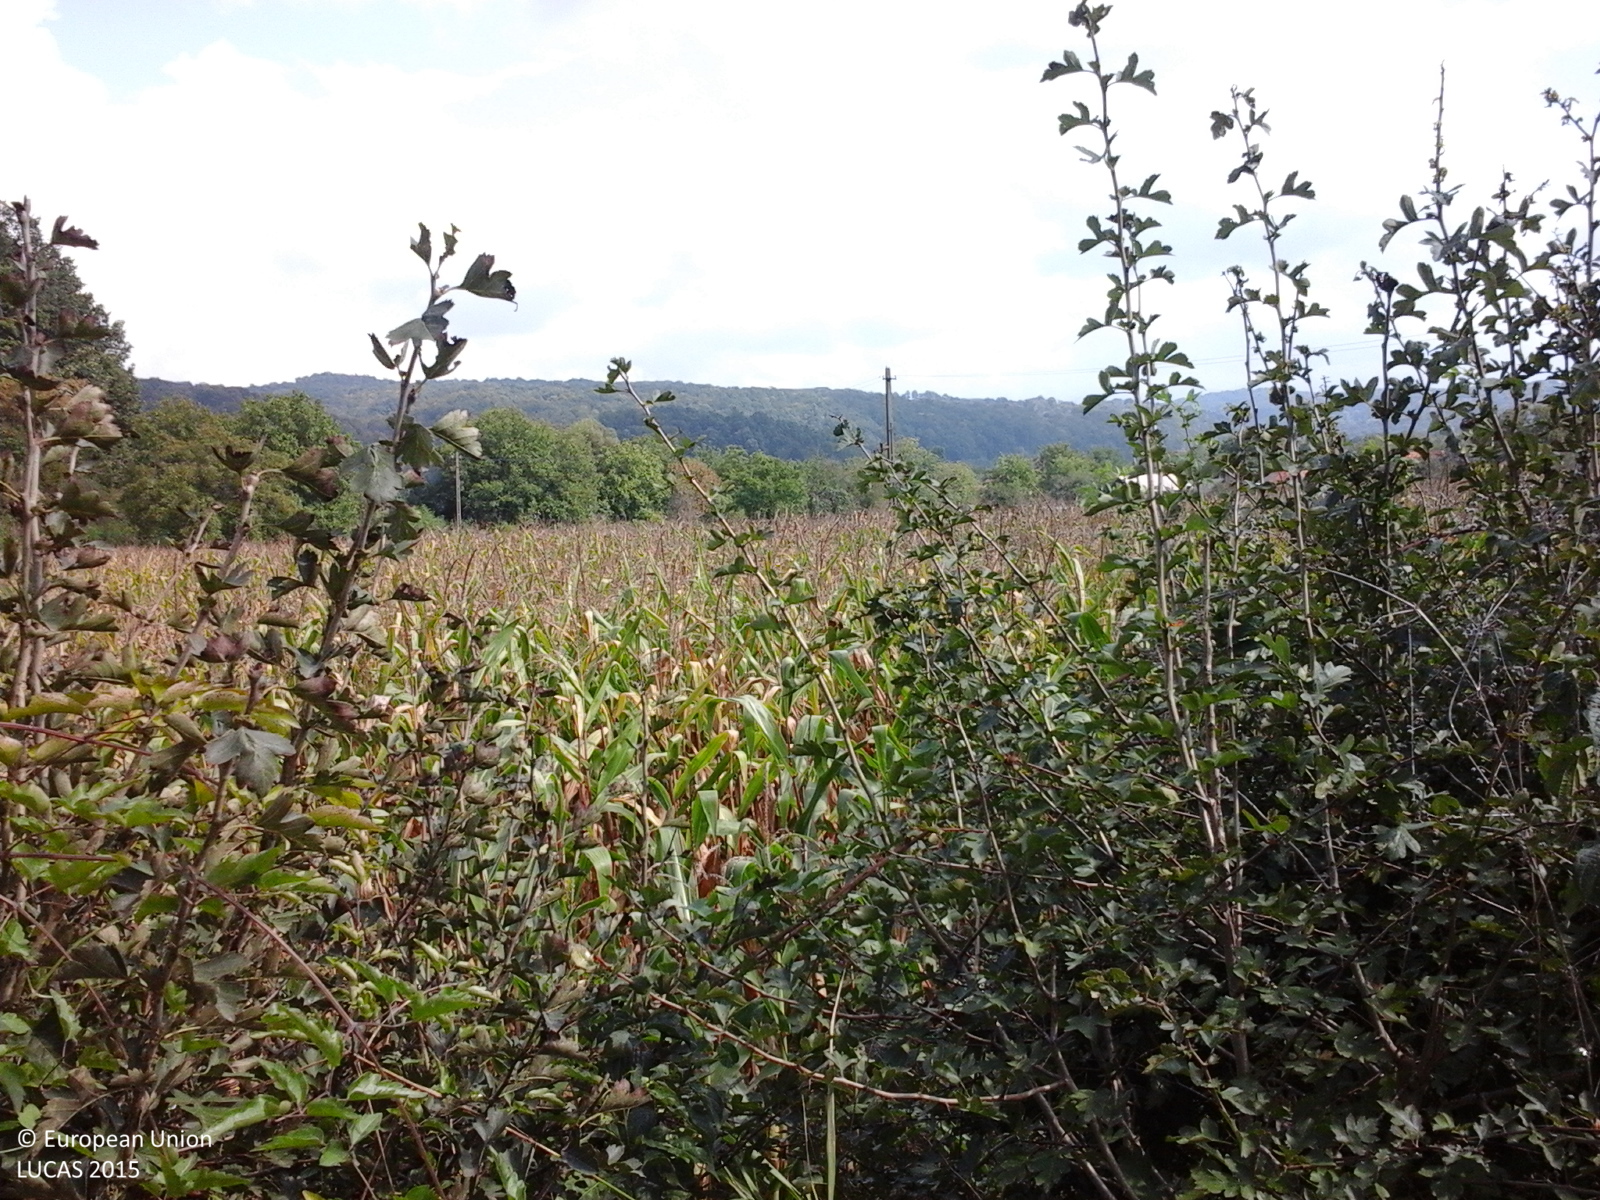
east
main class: Cropland
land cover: Maize
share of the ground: > 75 %
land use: Agriculture (excluding fallow land and kitchen gardens)
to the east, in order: Abandoned hedges; Electric lines; Abandoned hedges; Maize; Electric lines; Maize; Broadleaved woodland; Fences; Maize; Lucerne
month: September
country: RO
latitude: 46.7767
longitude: 22.3752
